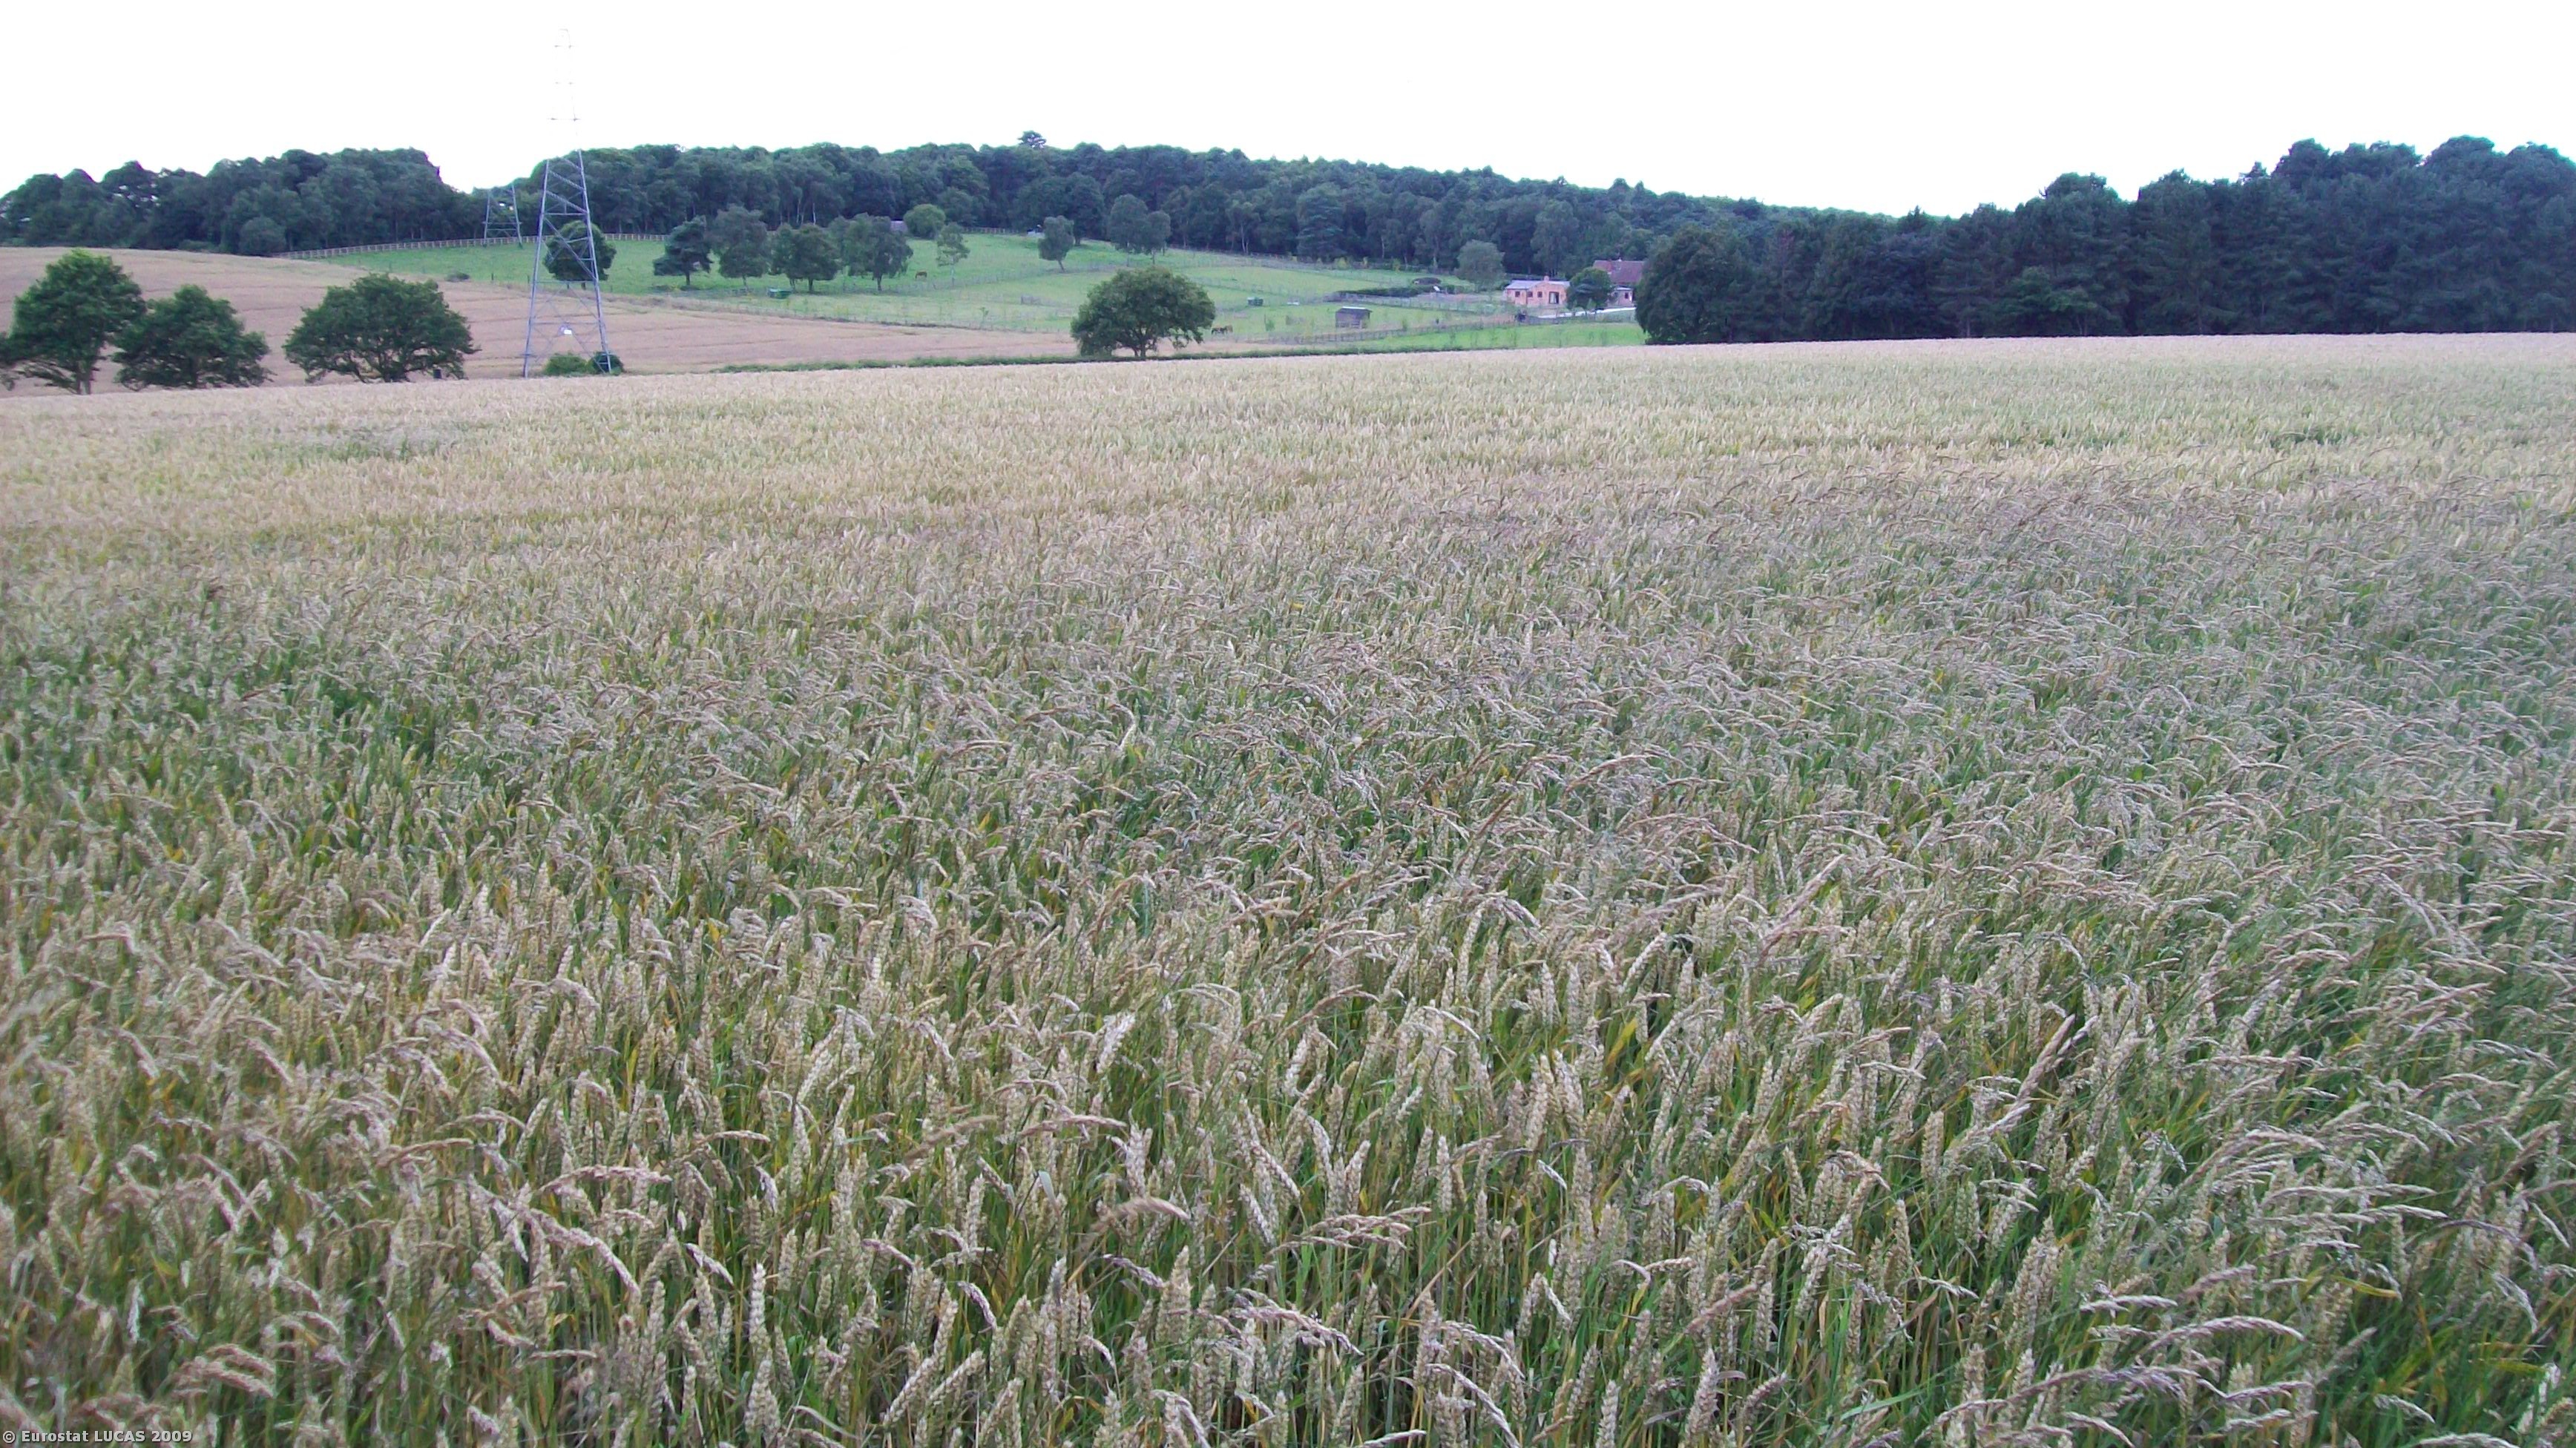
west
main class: Cropland
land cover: Common wheat
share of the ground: > 75 %
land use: Agriculture (excluding fallow land and kitchen gardens)
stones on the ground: 10 - 25 %
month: July
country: GB
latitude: 53.0682
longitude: -1.1342
